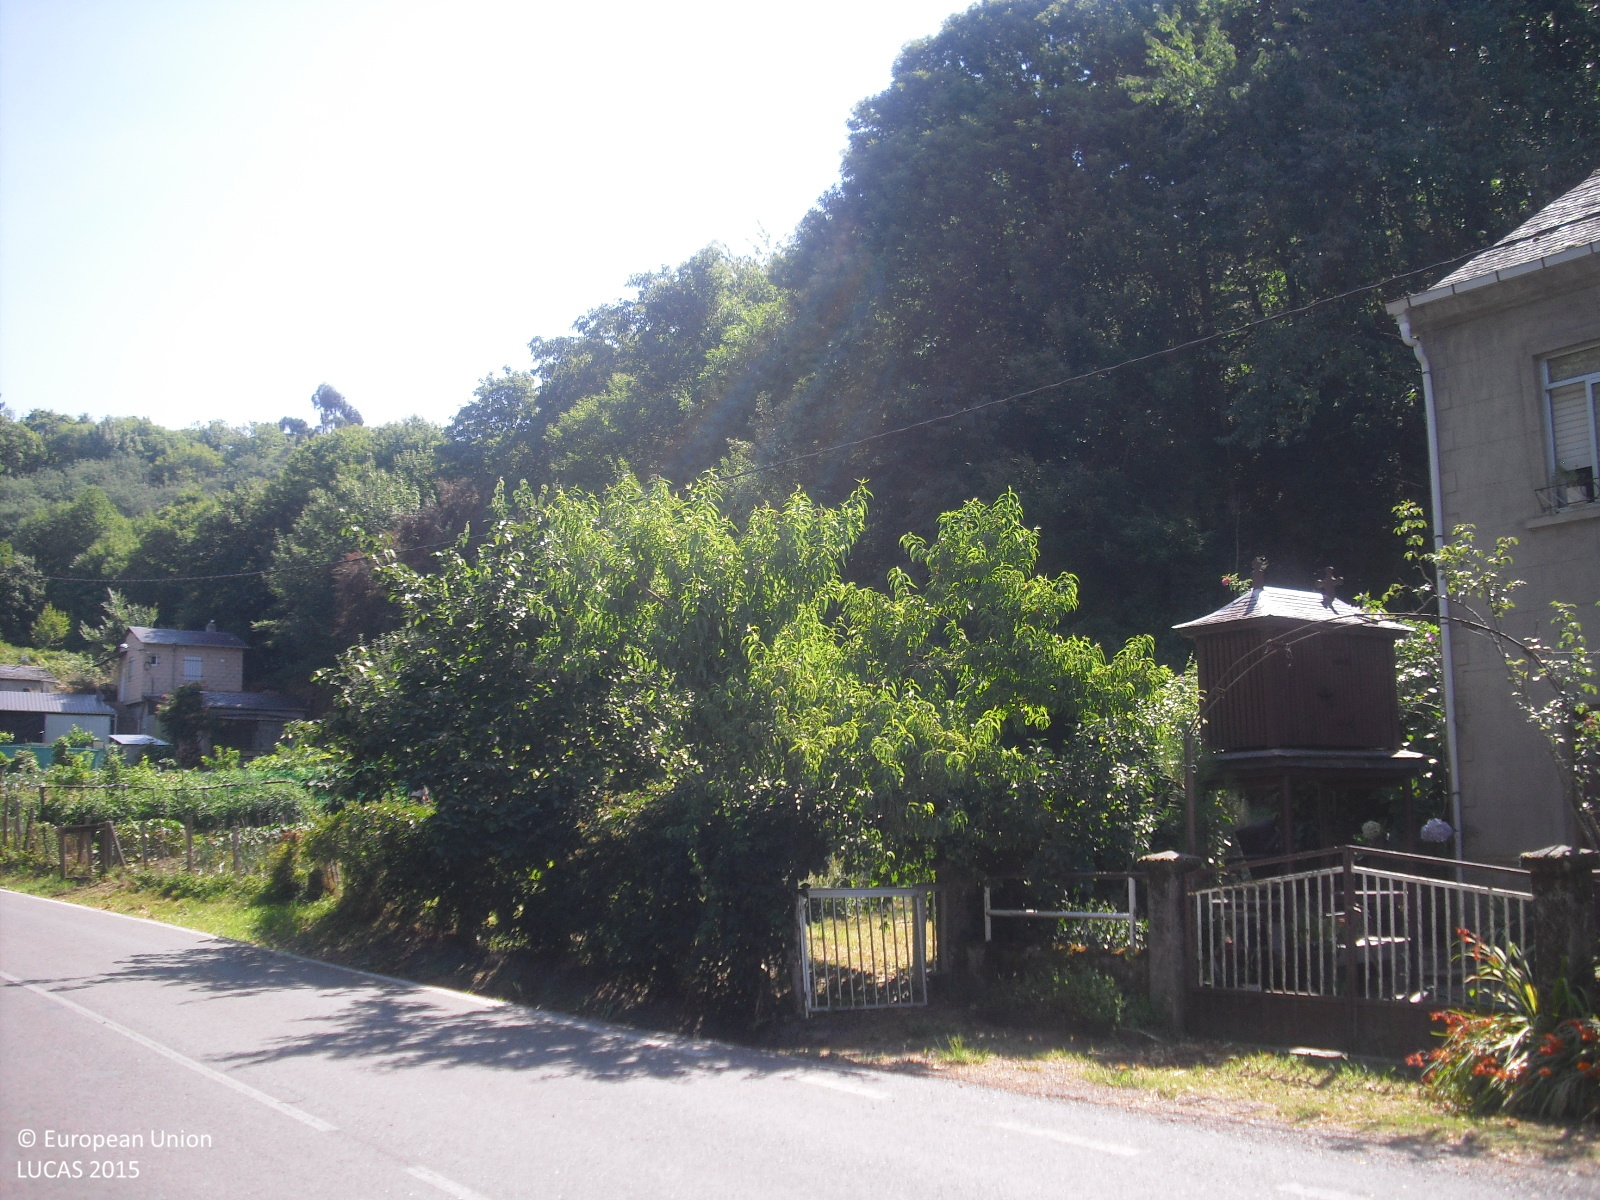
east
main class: Cropland
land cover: Other fruit trees and berries
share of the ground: 50 - 75 %
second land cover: Spontaneously vegetated surfaces
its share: 50 - 75 %
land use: Agriculture (excluding fallow land and kitchen gardens)
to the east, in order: Other fruit trees and berries; Spontaneously vegetated surfaces; Managed hedges; Paved roads, cycling and walking lanes; Ditches and canals; Managed hedges; Grassland with sparse tree/shrub cover; Electric lines; Grassland with sparse tree/shrub cover; Fences; Other fresh vegetables; Nuts trees; Electric lines; Nuts trees; Electric lines; Nuts trees; Grass margins; Tracks; Shruby margins; Shrubland without tree cover; Shrubland with sparse tree cover; Nuts trees; Dry stone walls; Tracks; Broadleaved woodland
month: July
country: ES
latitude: 42.4909
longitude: -7.2291
